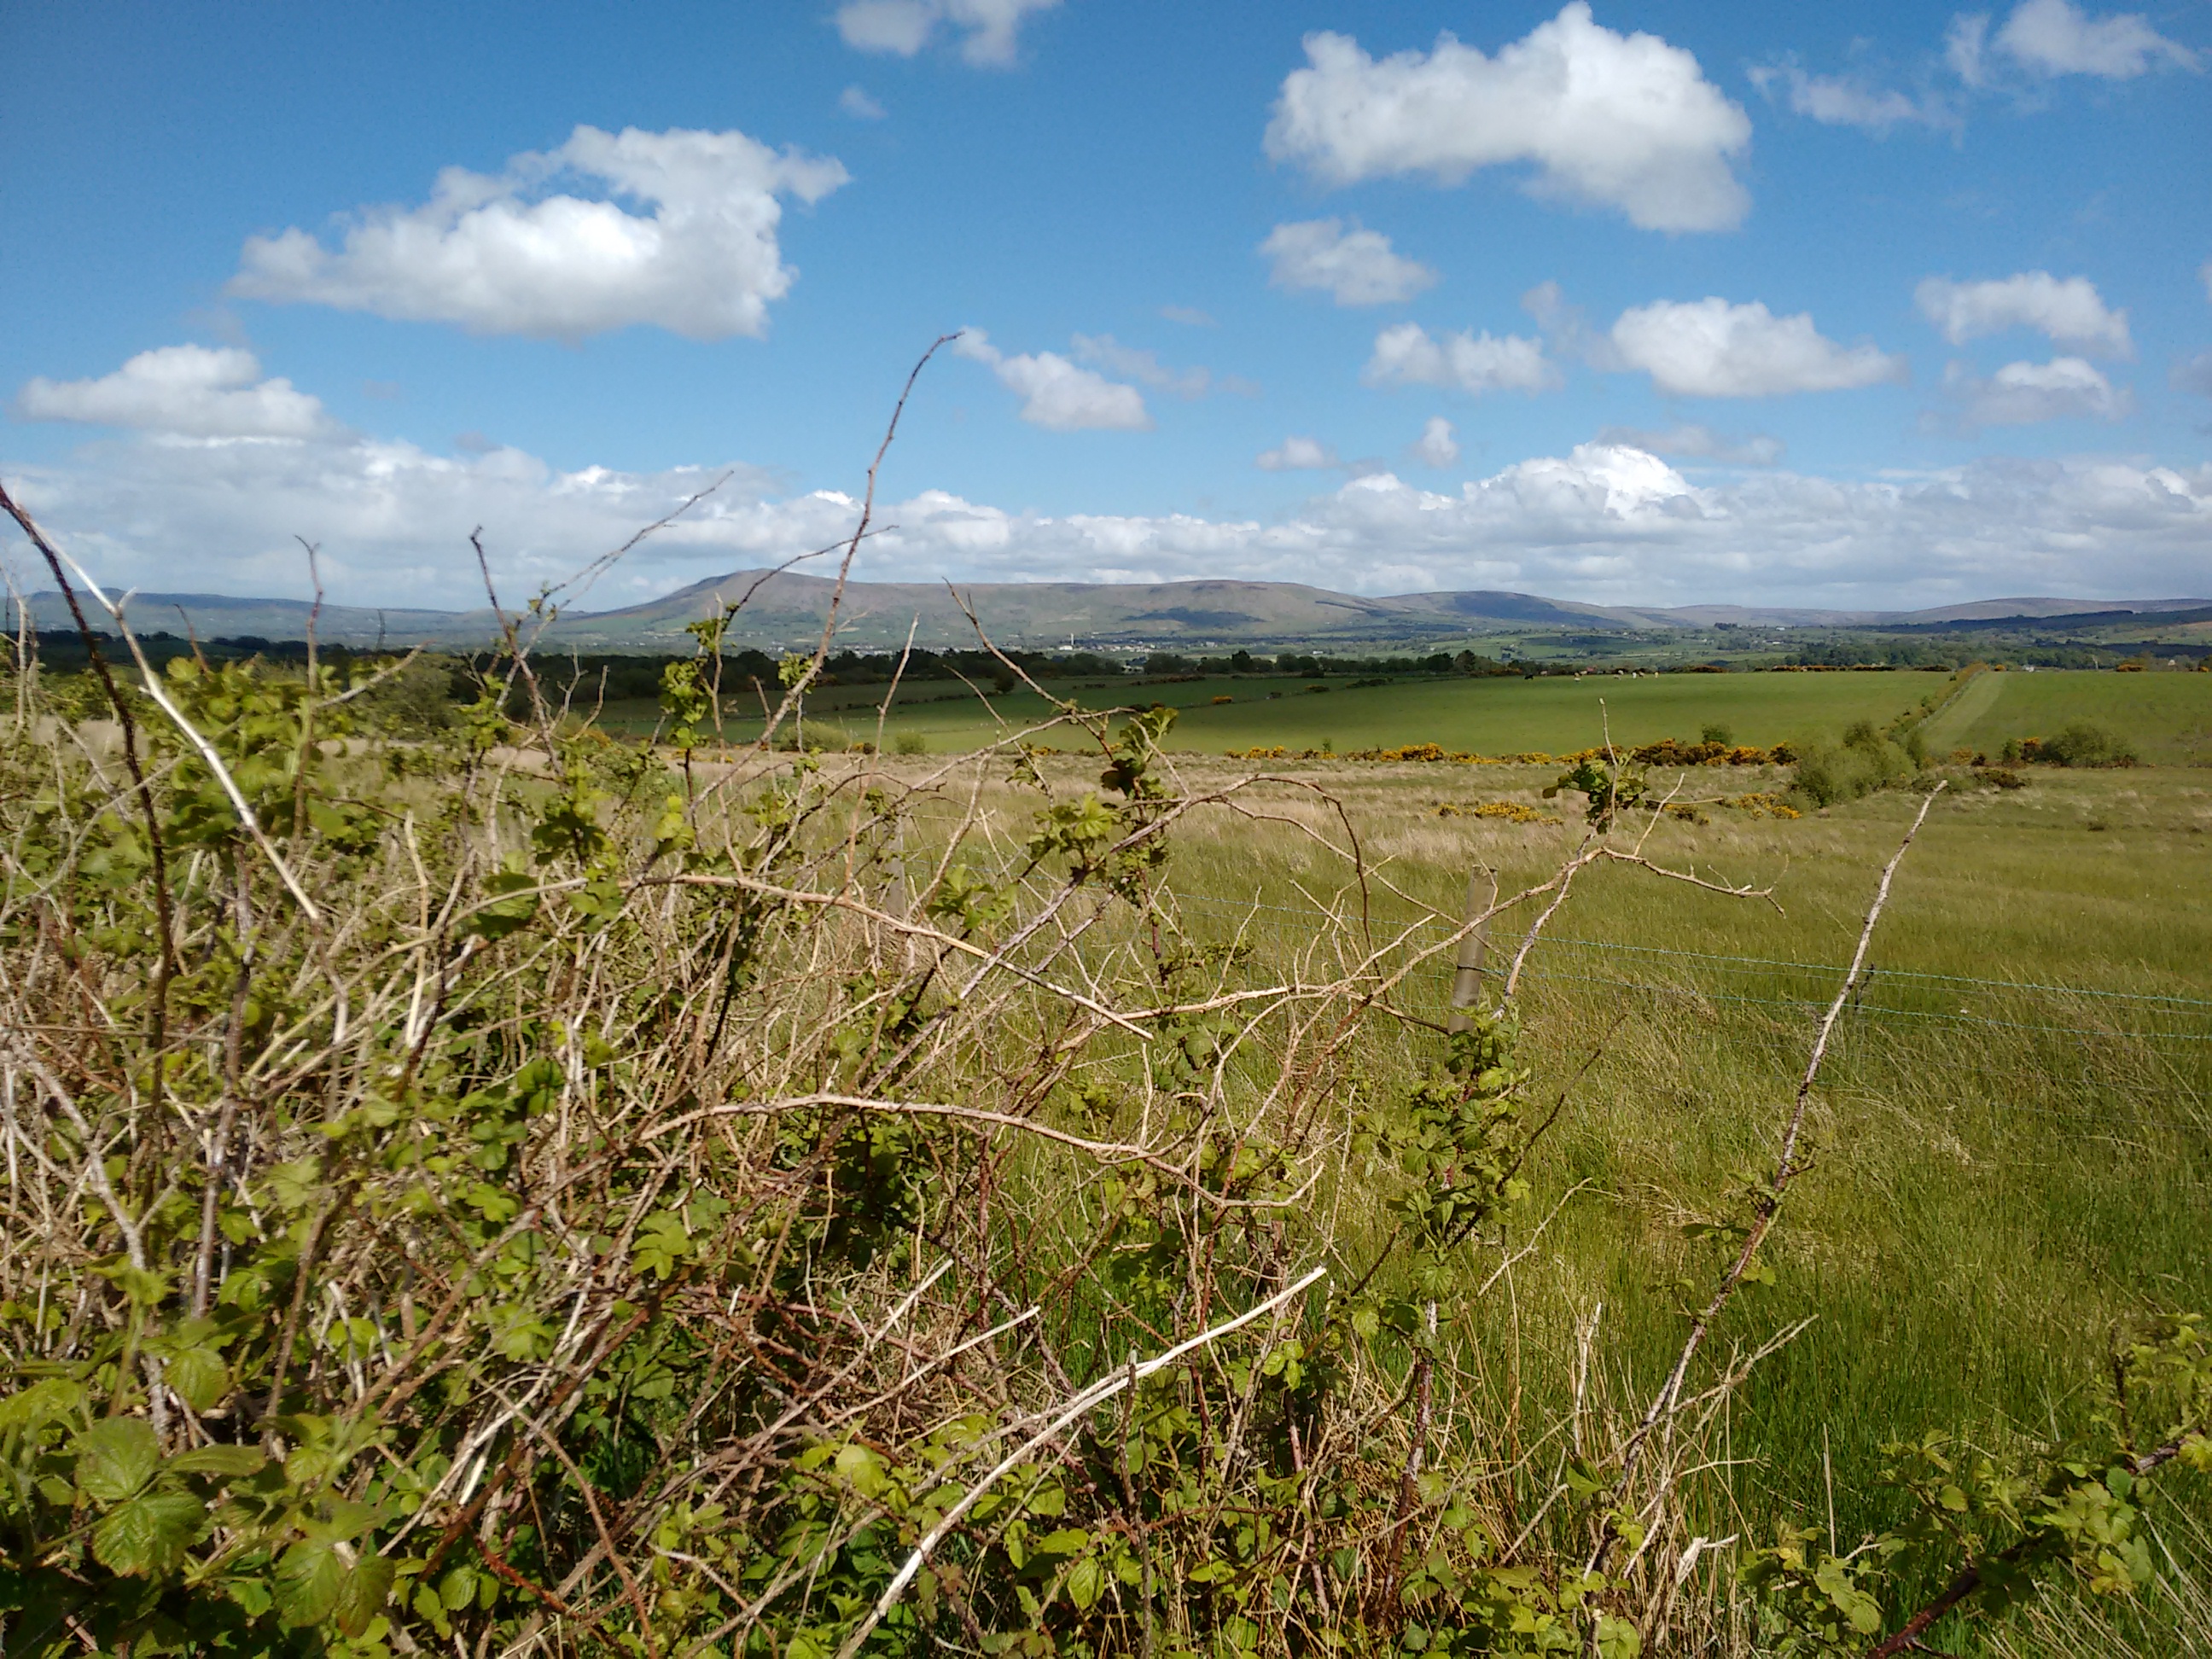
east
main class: Grassland
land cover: Grassland without tree/shrub cover
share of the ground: > 75 %
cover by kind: herbaceous plants 100 %
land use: Agriculture (excluding fallow land and kitchen gardens)
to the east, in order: Grassland without tree/shrub cover; Ditches and canals; Lines of trees; Grassland without tree/shrub cover; Abandoned hedges; Grassland without tree/shrub cover
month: June
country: GB
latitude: 54.9114
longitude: -7.0003
